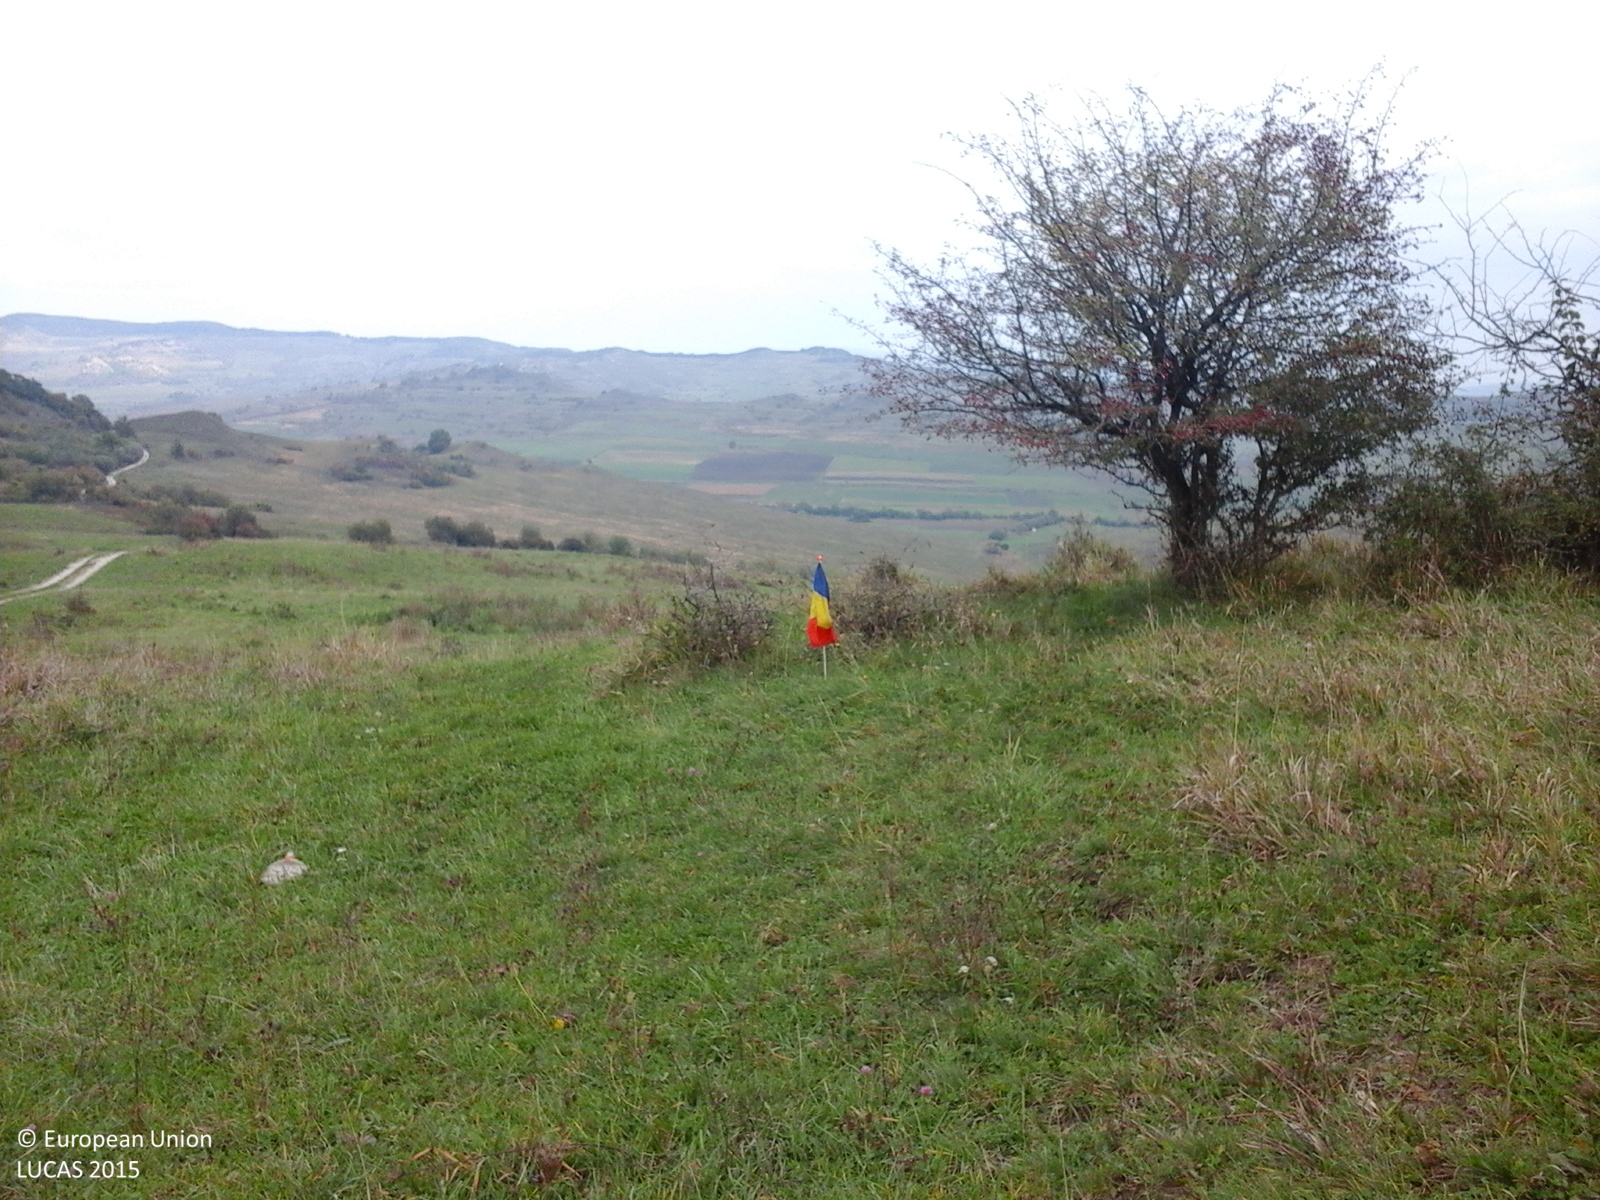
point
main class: Grassland
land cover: Grassland with sparse tree/shrub cover
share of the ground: > 75 %
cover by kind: herbaceous plants 85 %, shrubs 10 %, broadleaved forest trees 5 %
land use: Agriculture (excluding fallow land and kitchen gardens)
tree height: < 5 m
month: October
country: RO
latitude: 46.3057
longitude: 24.9089
